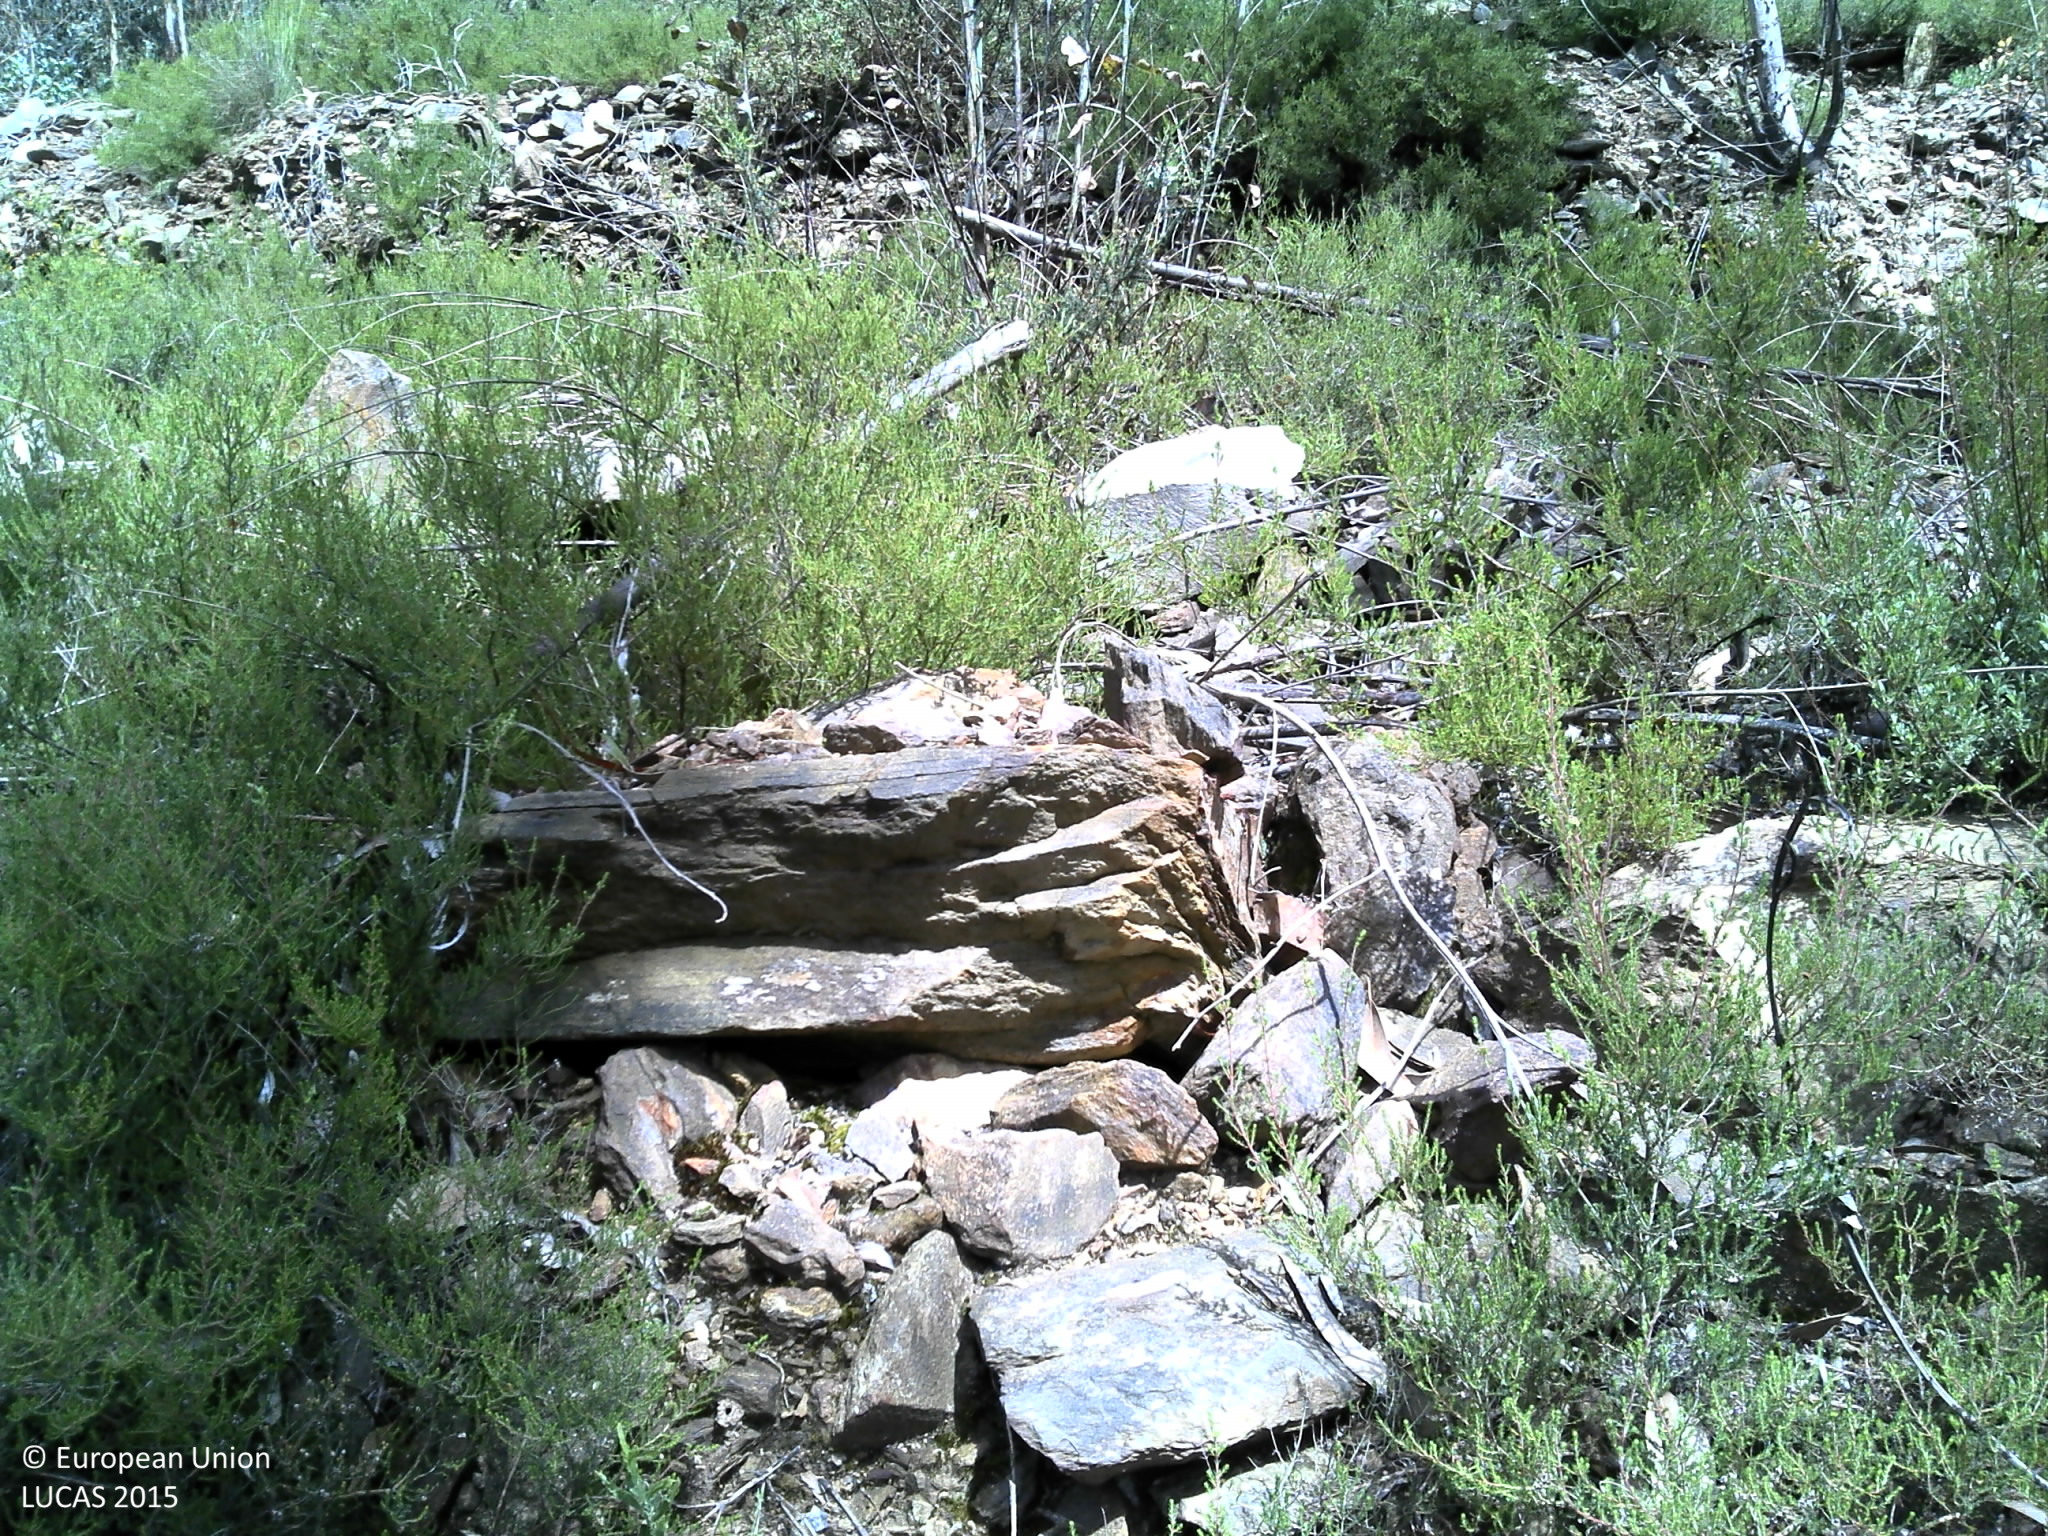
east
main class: Woodland
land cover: Broadleaved woodland
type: exotic forest
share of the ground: 50 - 75 %
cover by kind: broadleaved forest trees 70 %, shrubs 25 %, unconsolidated bare surface 5 %
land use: Forestry
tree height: > 5 m
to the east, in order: Broadleaved woodland; Tracks; Broadleaved woodland; Tracks; Shrubland with sparse tree cover; Shrubland without tree cover
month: May
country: PT
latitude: 41.2565
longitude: -8.4457
